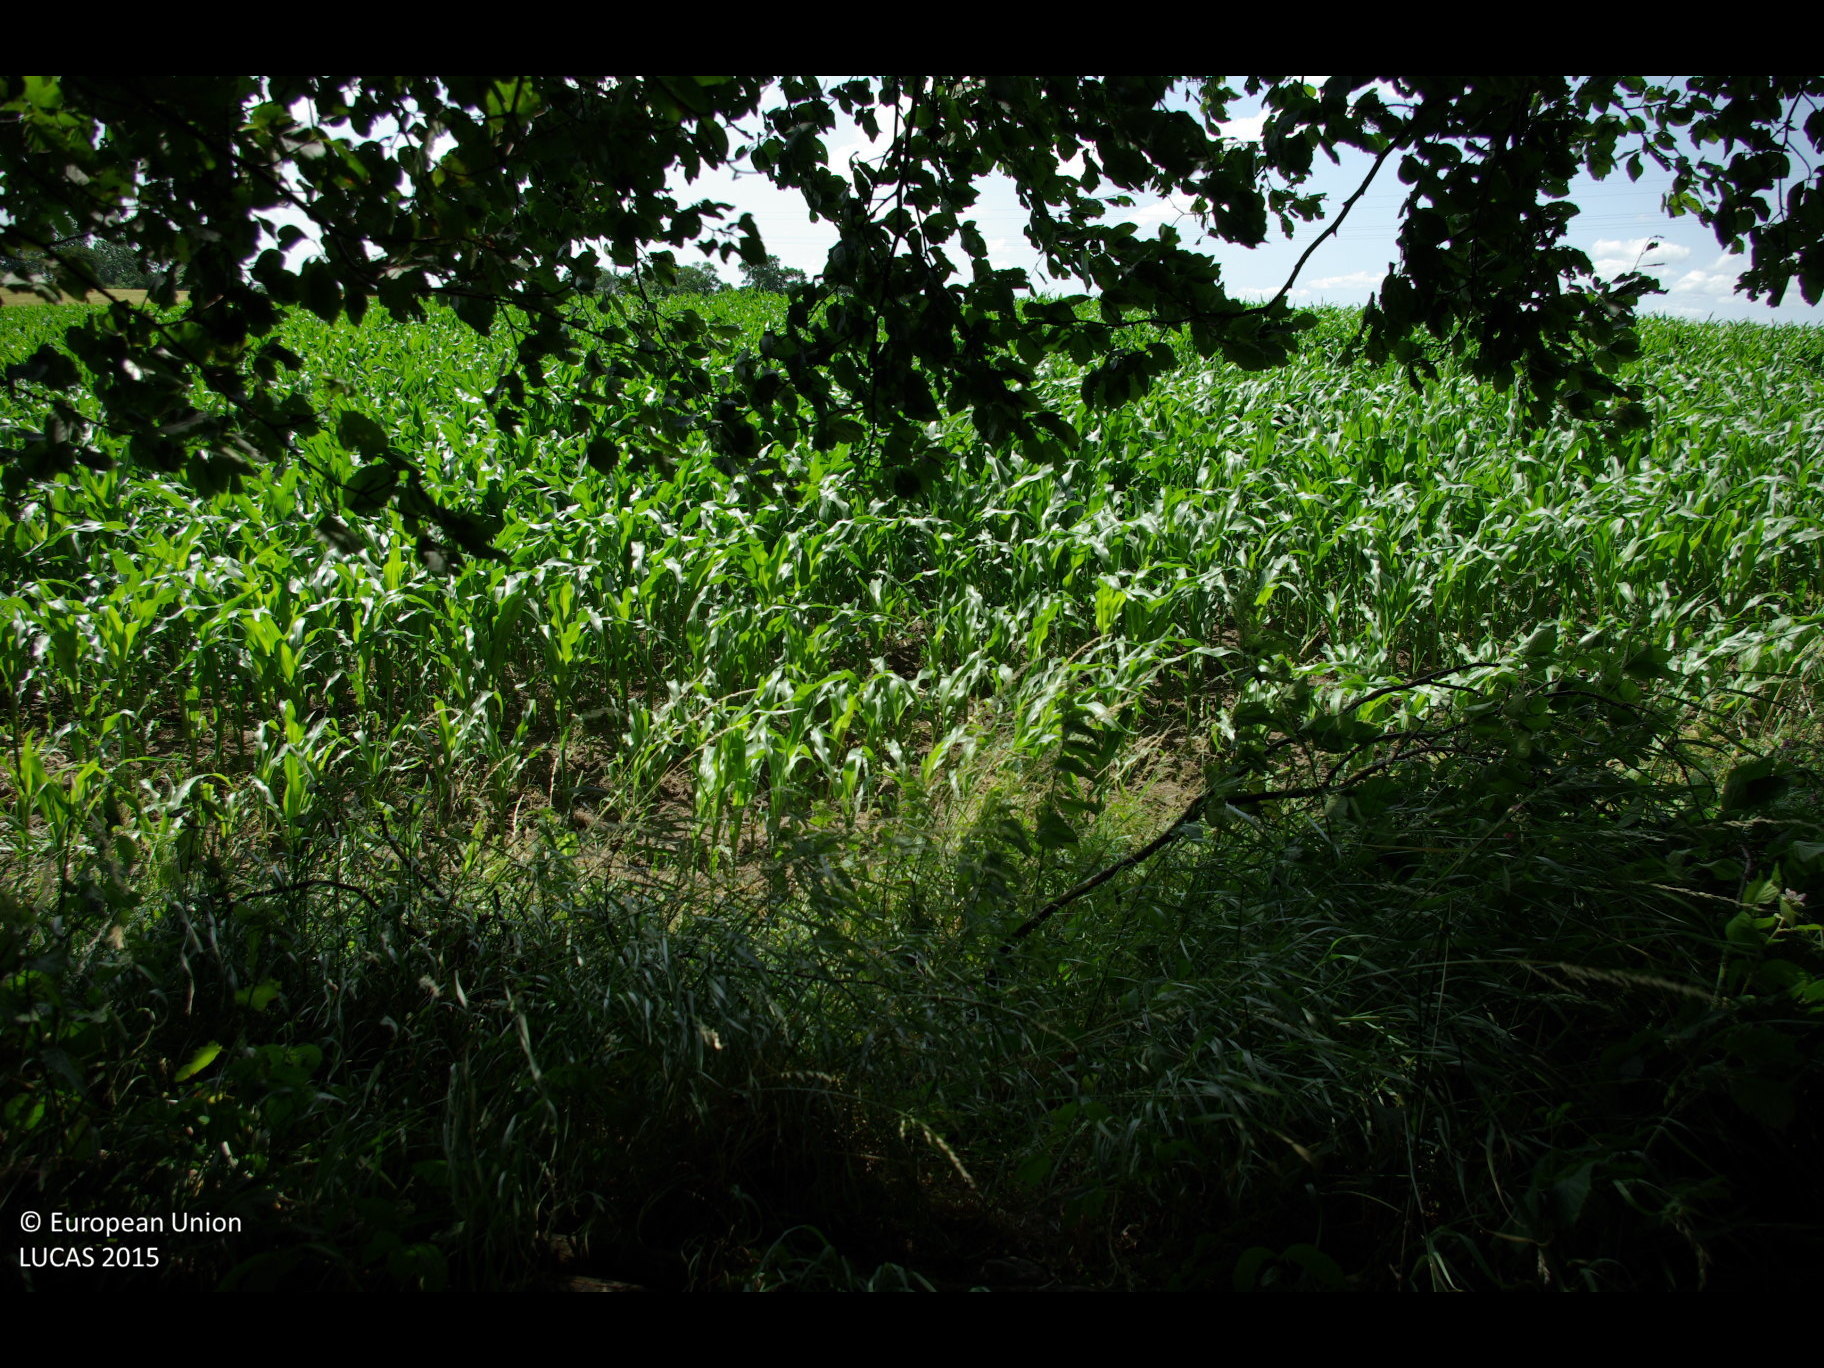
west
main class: Woodland
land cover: Other mixed woodland
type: hemiboreal forest and nemoral coniferous forest and mixed broadleaved-coniferous forest
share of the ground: > 75 %
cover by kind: coniferous forest trees 40 %, broadleaved forest trees 40 %, herbaceous plants 20 %
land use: Forestry
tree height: > 5 m
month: July
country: DE
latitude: 54.5701
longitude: 9.8918
